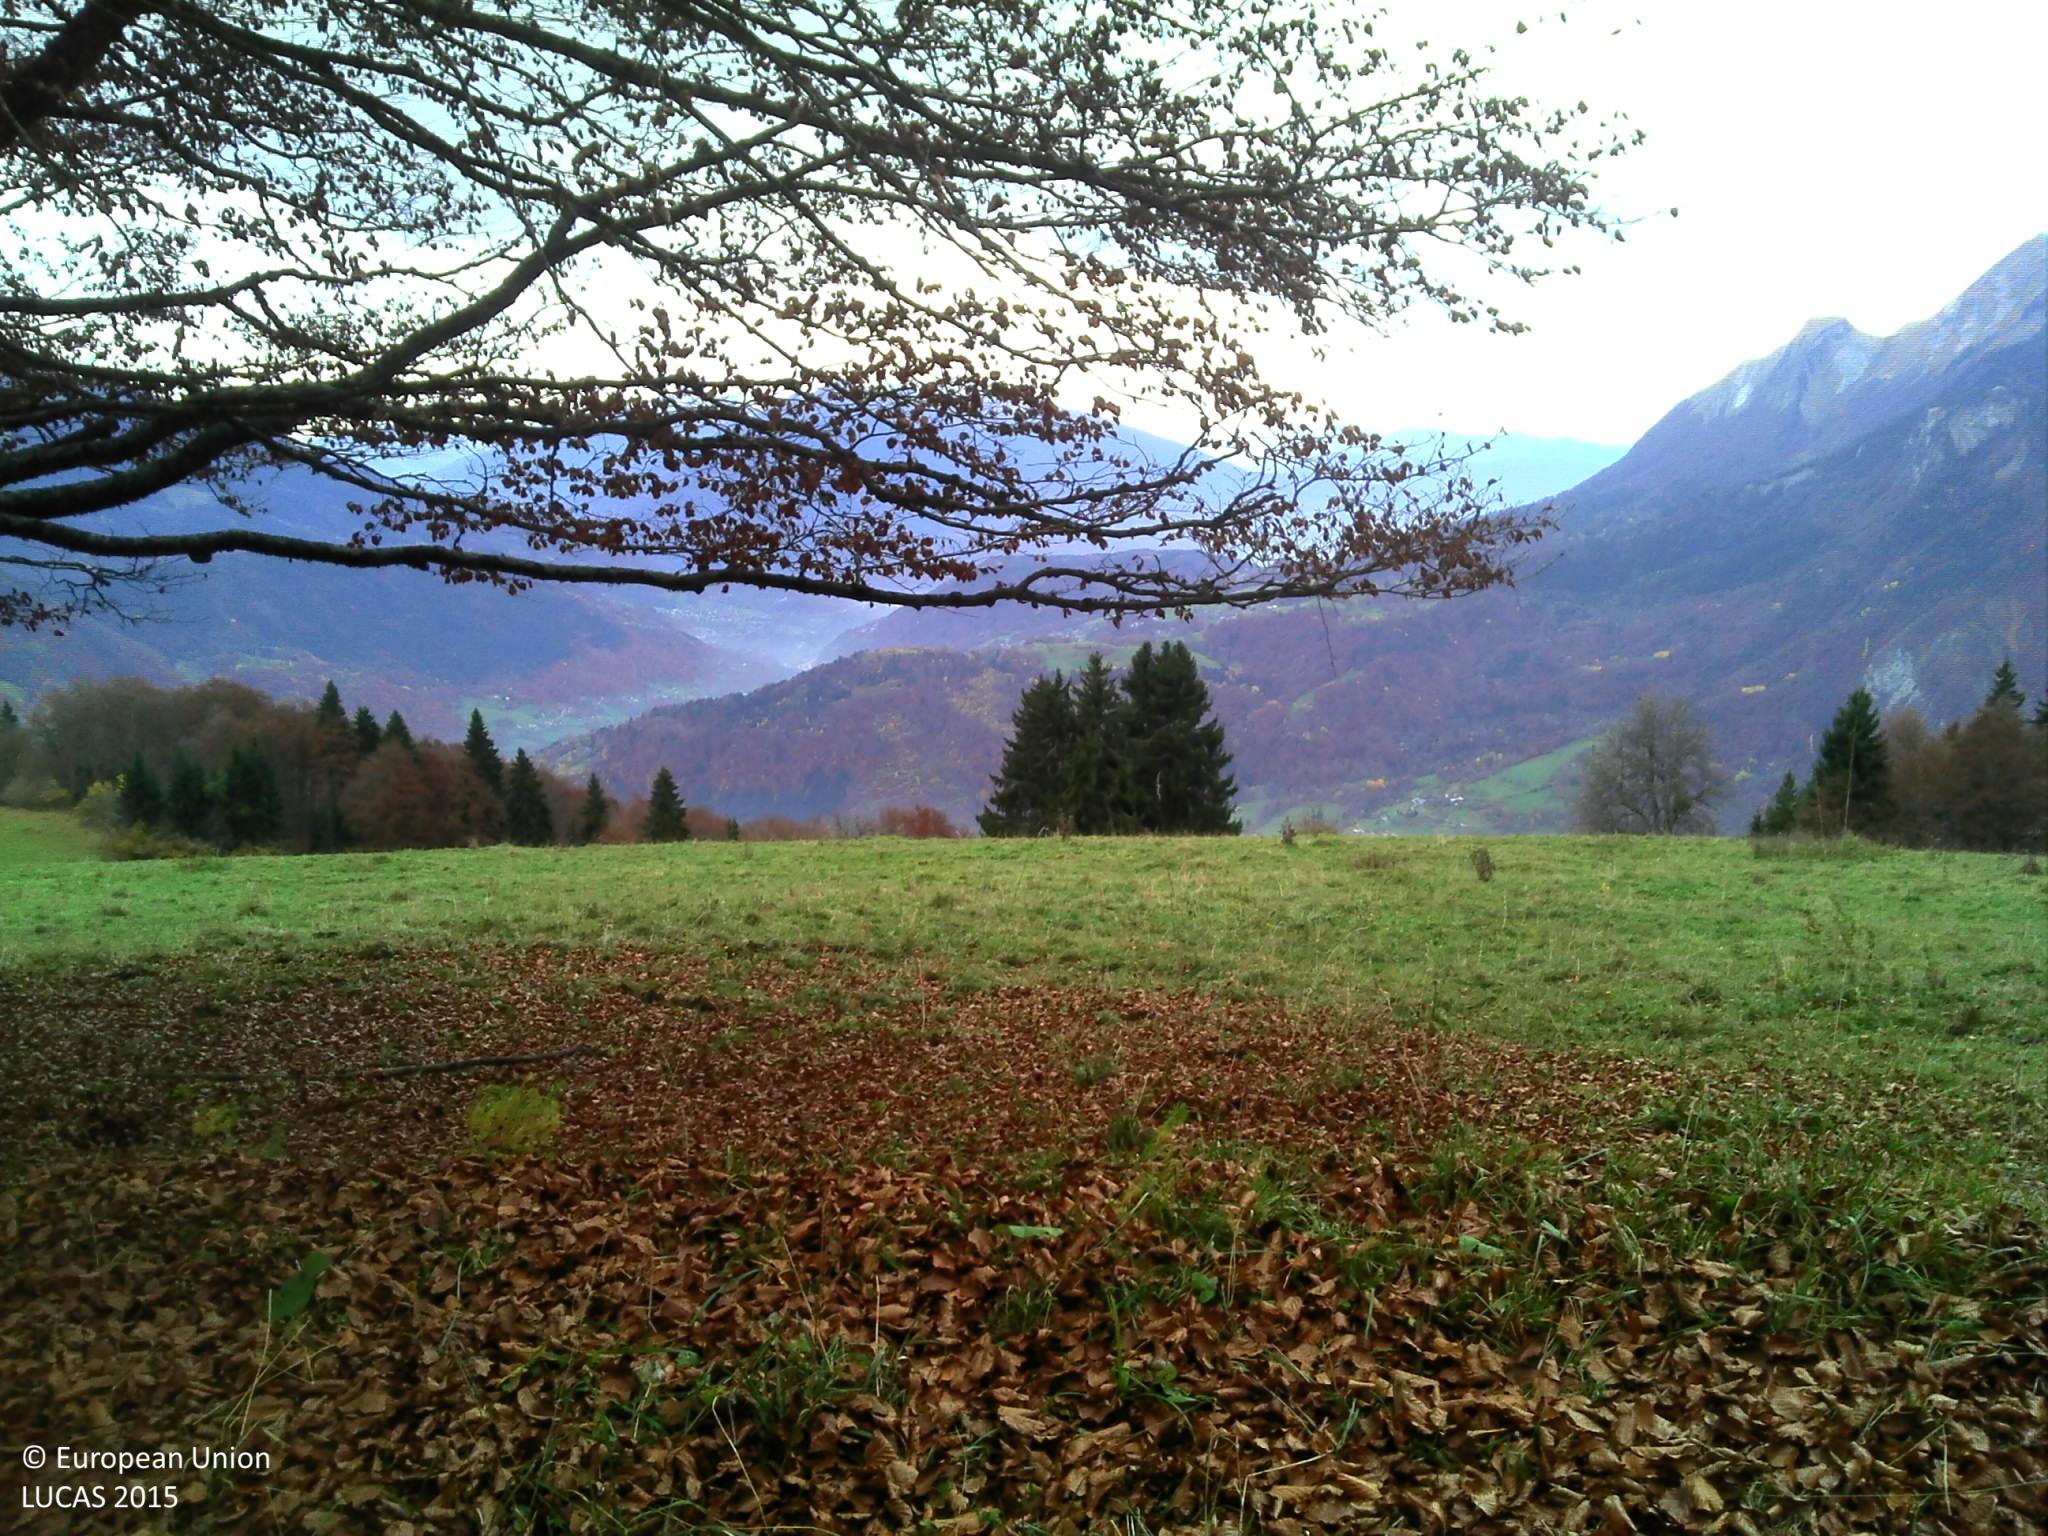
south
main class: Woodland
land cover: Spruce dominated mixed woodland
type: mountainous beech forest
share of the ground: > 75 %
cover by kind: broadleaved forest trees 50 %, coniferous forest trees 30 %, unconsolidated bare surface 15 %, shrubs 5 %
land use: Forestry
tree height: > 5 m
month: November
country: FR
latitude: 45.7863
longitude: 6.4154
